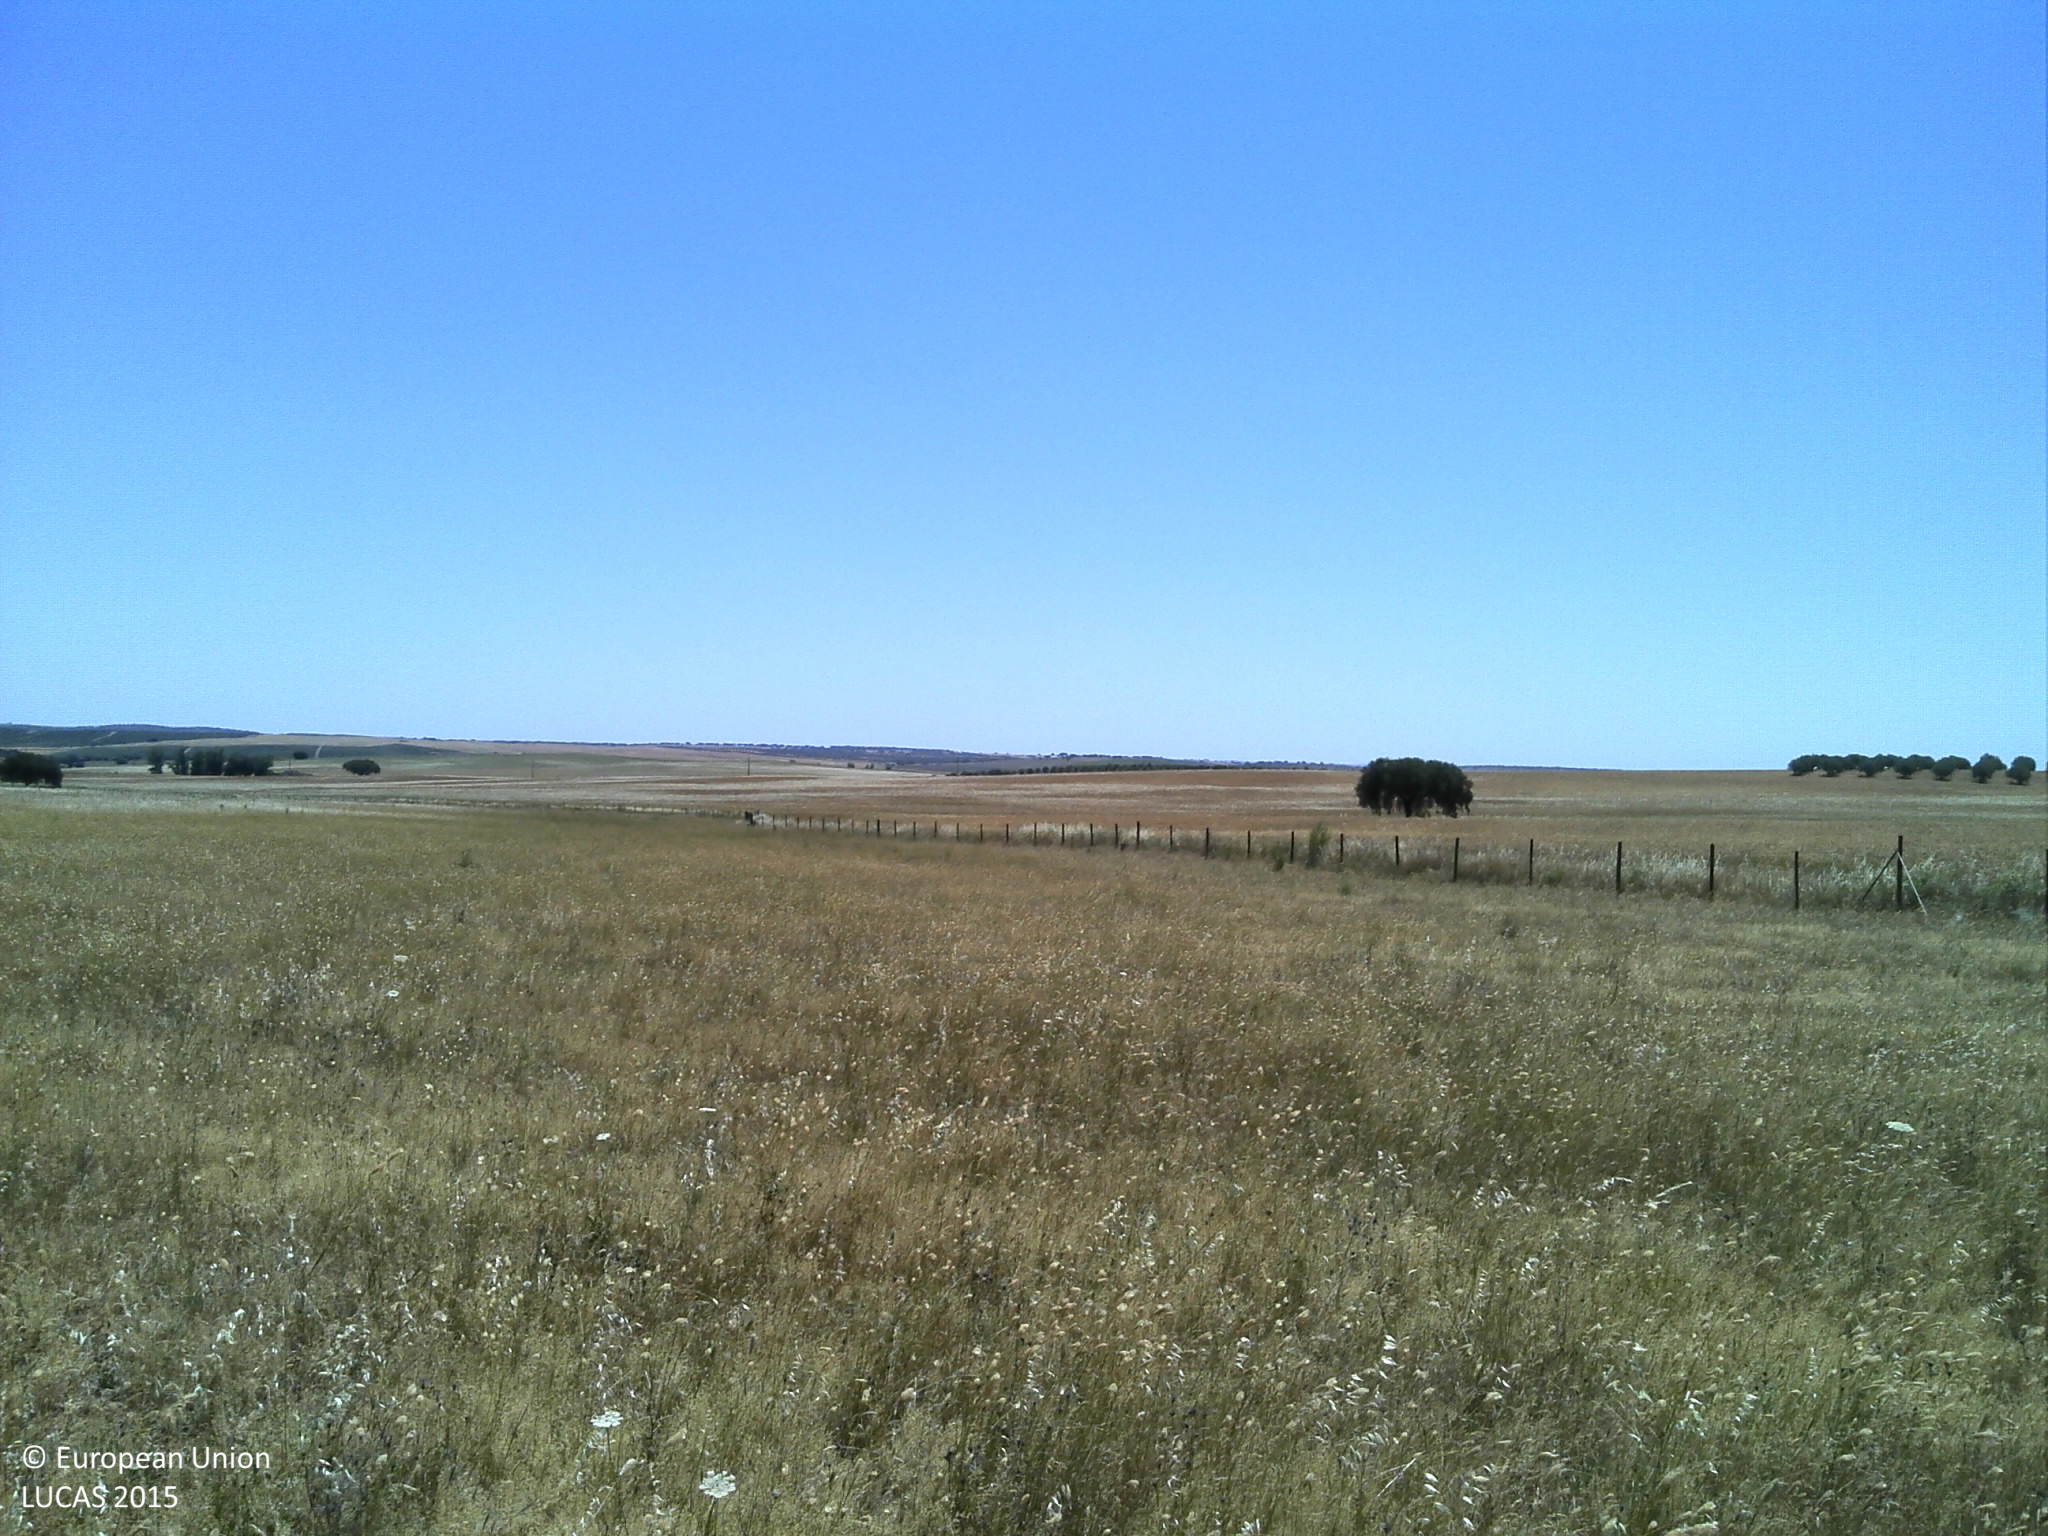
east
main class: Grassland
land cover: Grassland without tree/shrub cover
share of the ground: > 75 %
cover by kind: herbaceous plants 80 %, unconsolidated bare surface 20 %
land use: Agriculture (excluding fallow land and kitchen gardens)
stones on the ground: < 10 %
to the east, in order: Grassland without tree/shrub cover
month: May
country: PT
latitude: 39.0295
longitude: -7.6107
